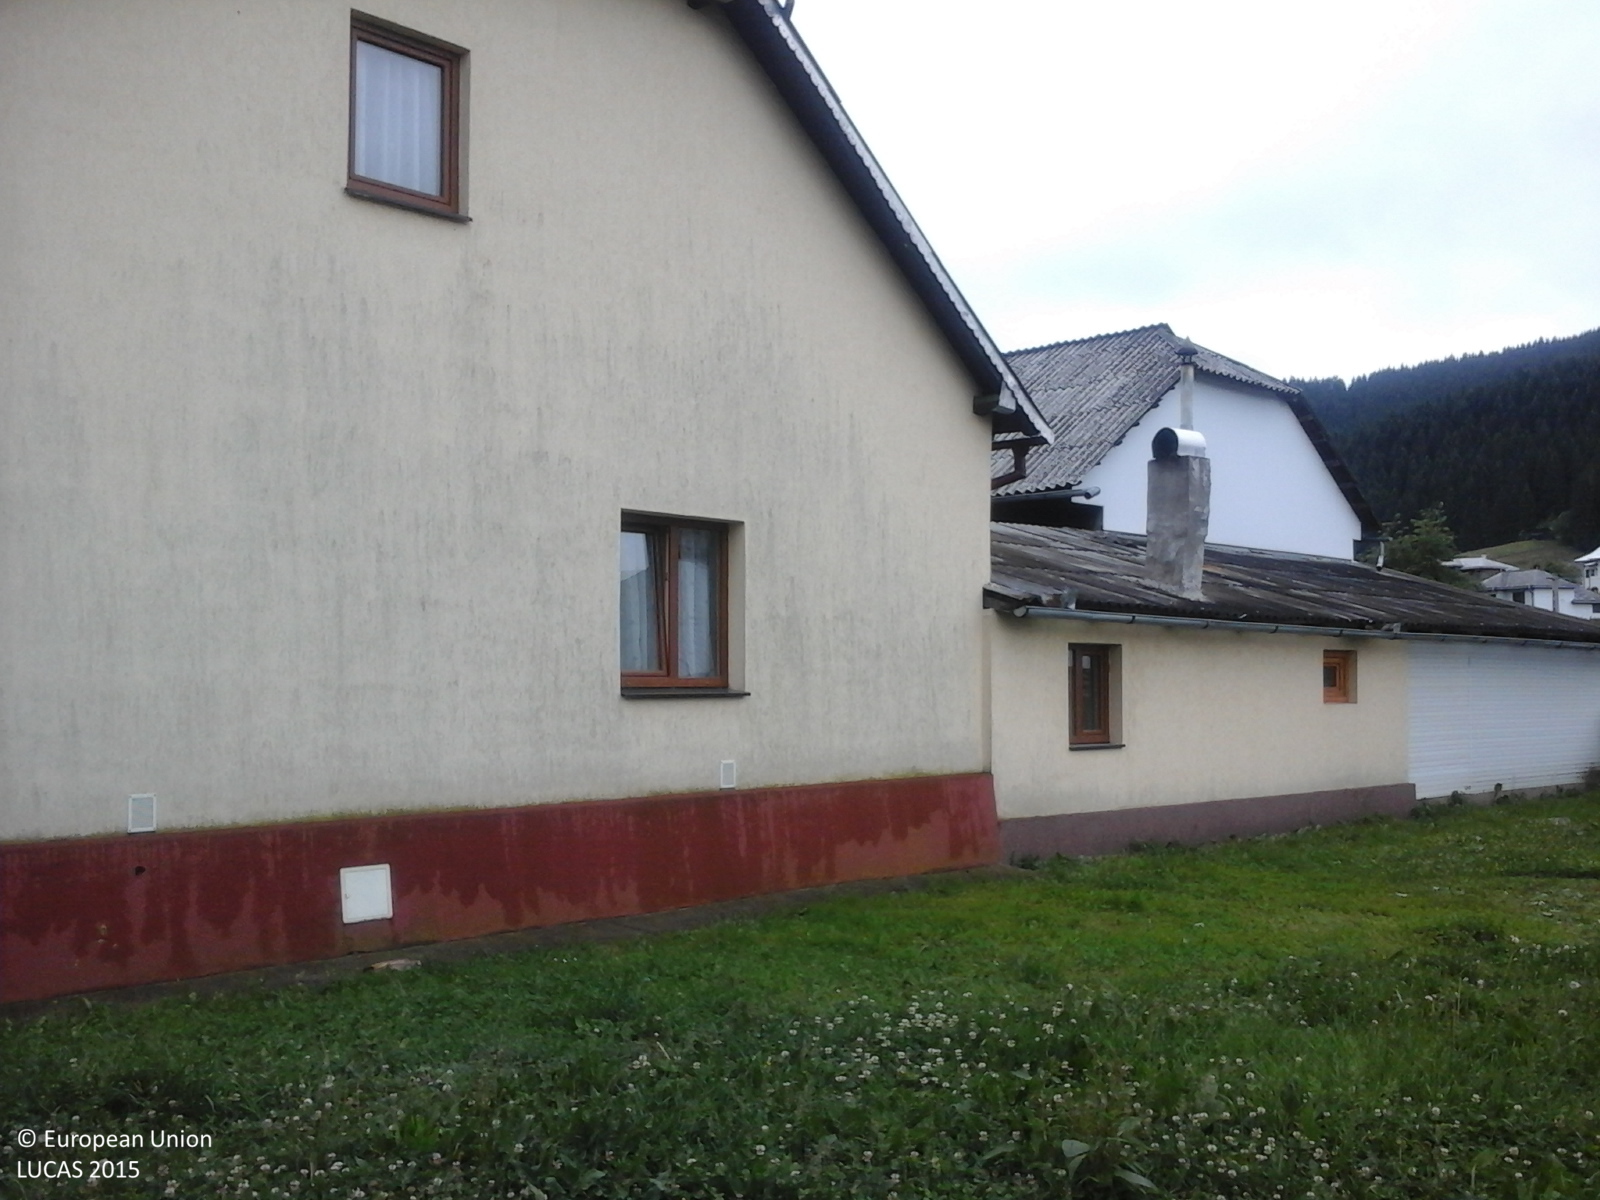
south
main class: Grassland
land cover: Grassland without tree/shrub cover
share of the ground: > 75 %
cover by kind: herbaceous plants 100 %
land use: Agriculture (excluding fallow land and kitchen gardens)
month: June
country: RO
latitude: 47.4650
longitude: 25.7634
